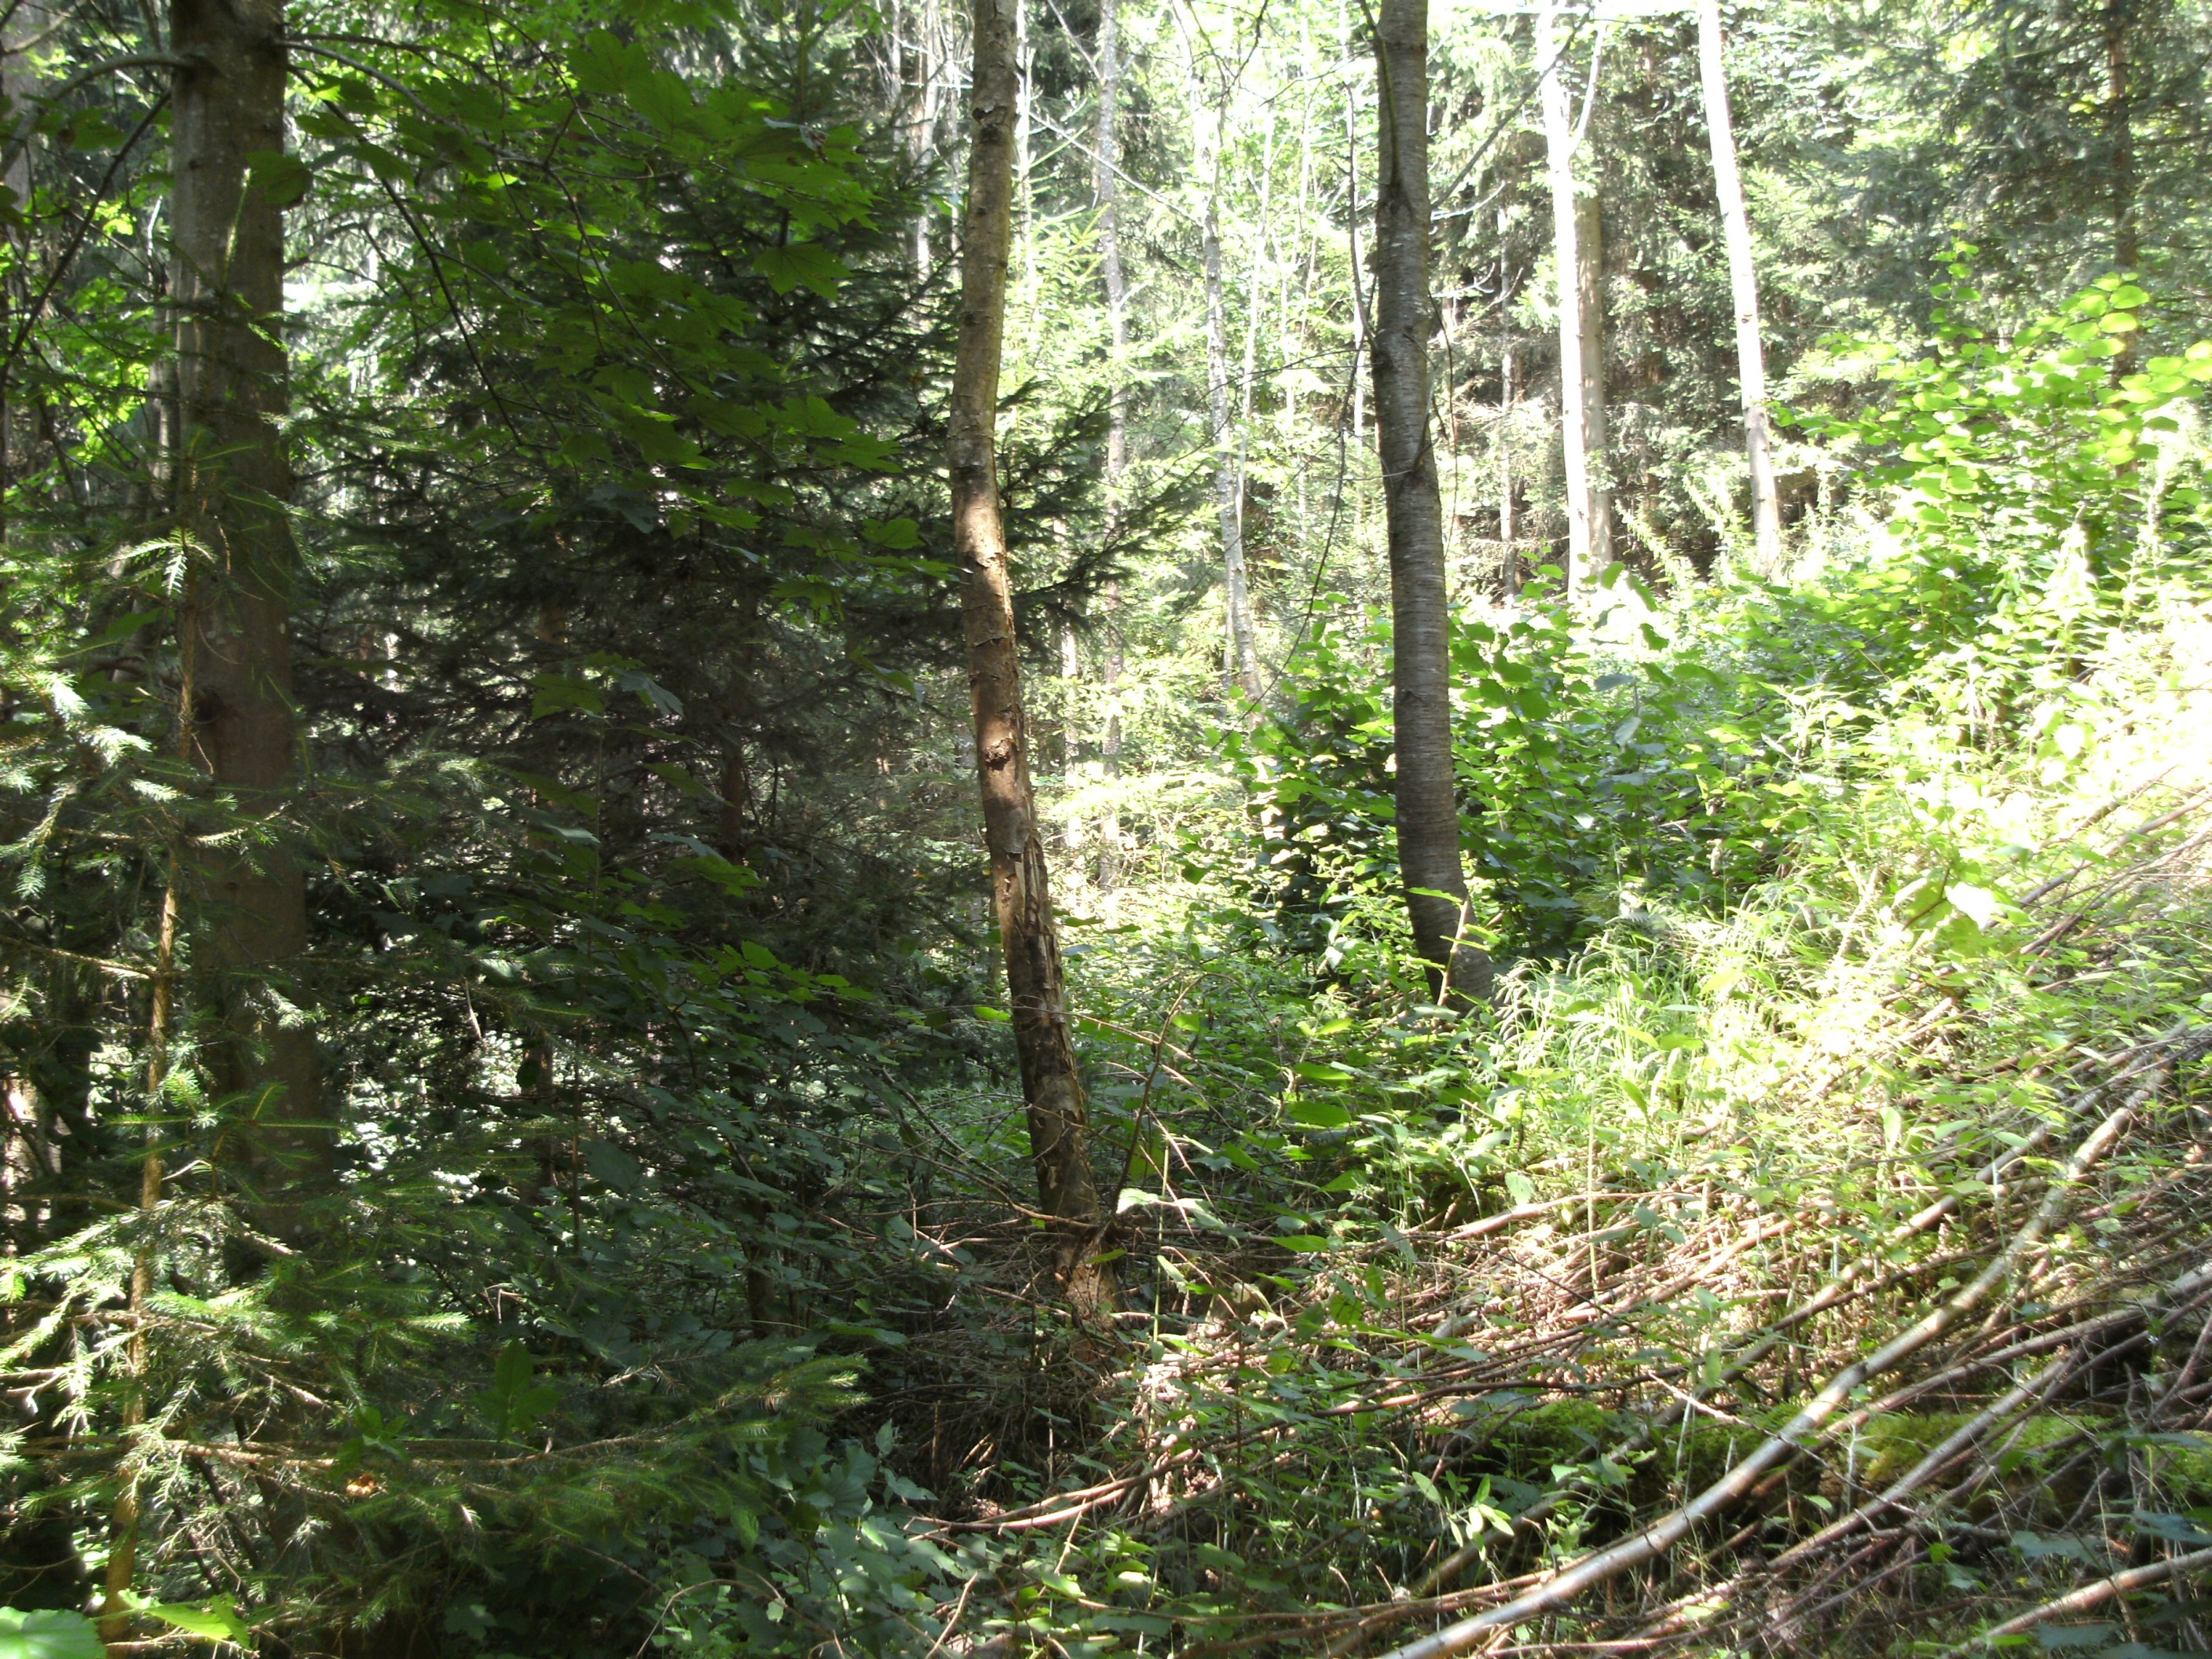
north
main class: Woodland
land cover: Spruce dominated mixed woodland
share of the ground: 50 - 75 %
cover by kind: broadleaved forest trees 35 %, shrubs 30 %, coniferous forest trees 20 %, unconsolidated bare surface 10 %, herbaceous plants 5 %
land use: Forestry
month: July
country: AT
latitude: 46.7677
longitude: 14.7777
